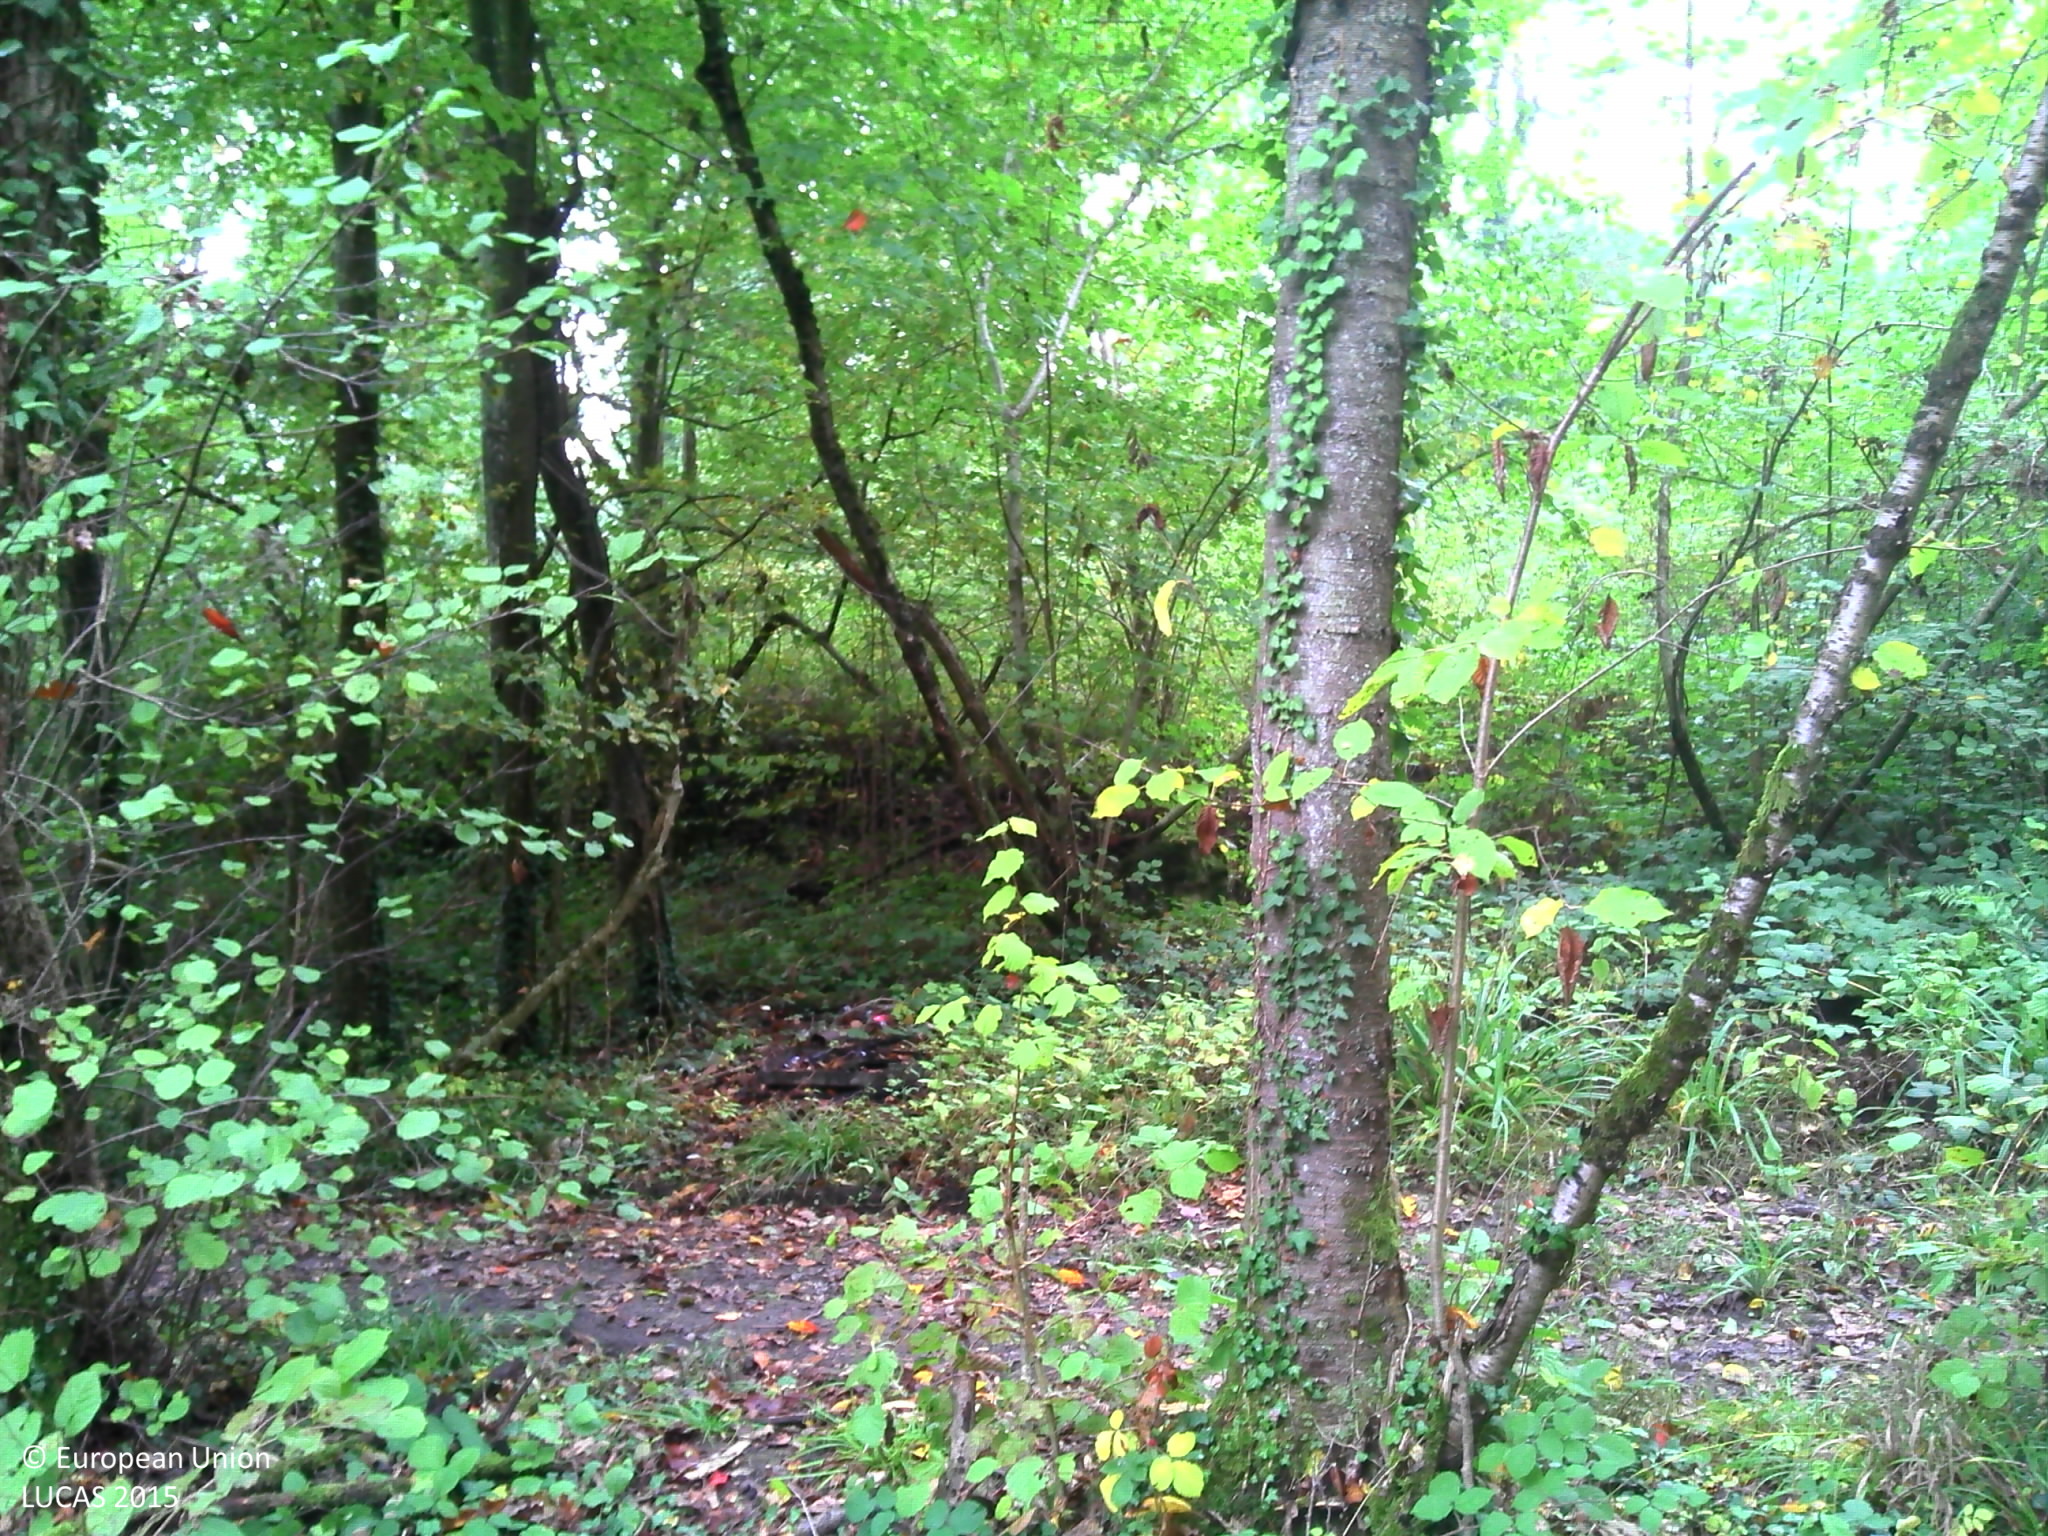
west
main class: Woodland
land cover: Broadleaved woodland
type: acidophilous oak and oak-birch forest
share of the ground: > 75 %
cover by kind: broadleaved forest trees 75 %, herbaceous plants 20 %, shrubs 5 %
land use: Forestry
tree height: > 5 m
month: October
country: FR
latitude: 49.0325
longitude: 3.3315
